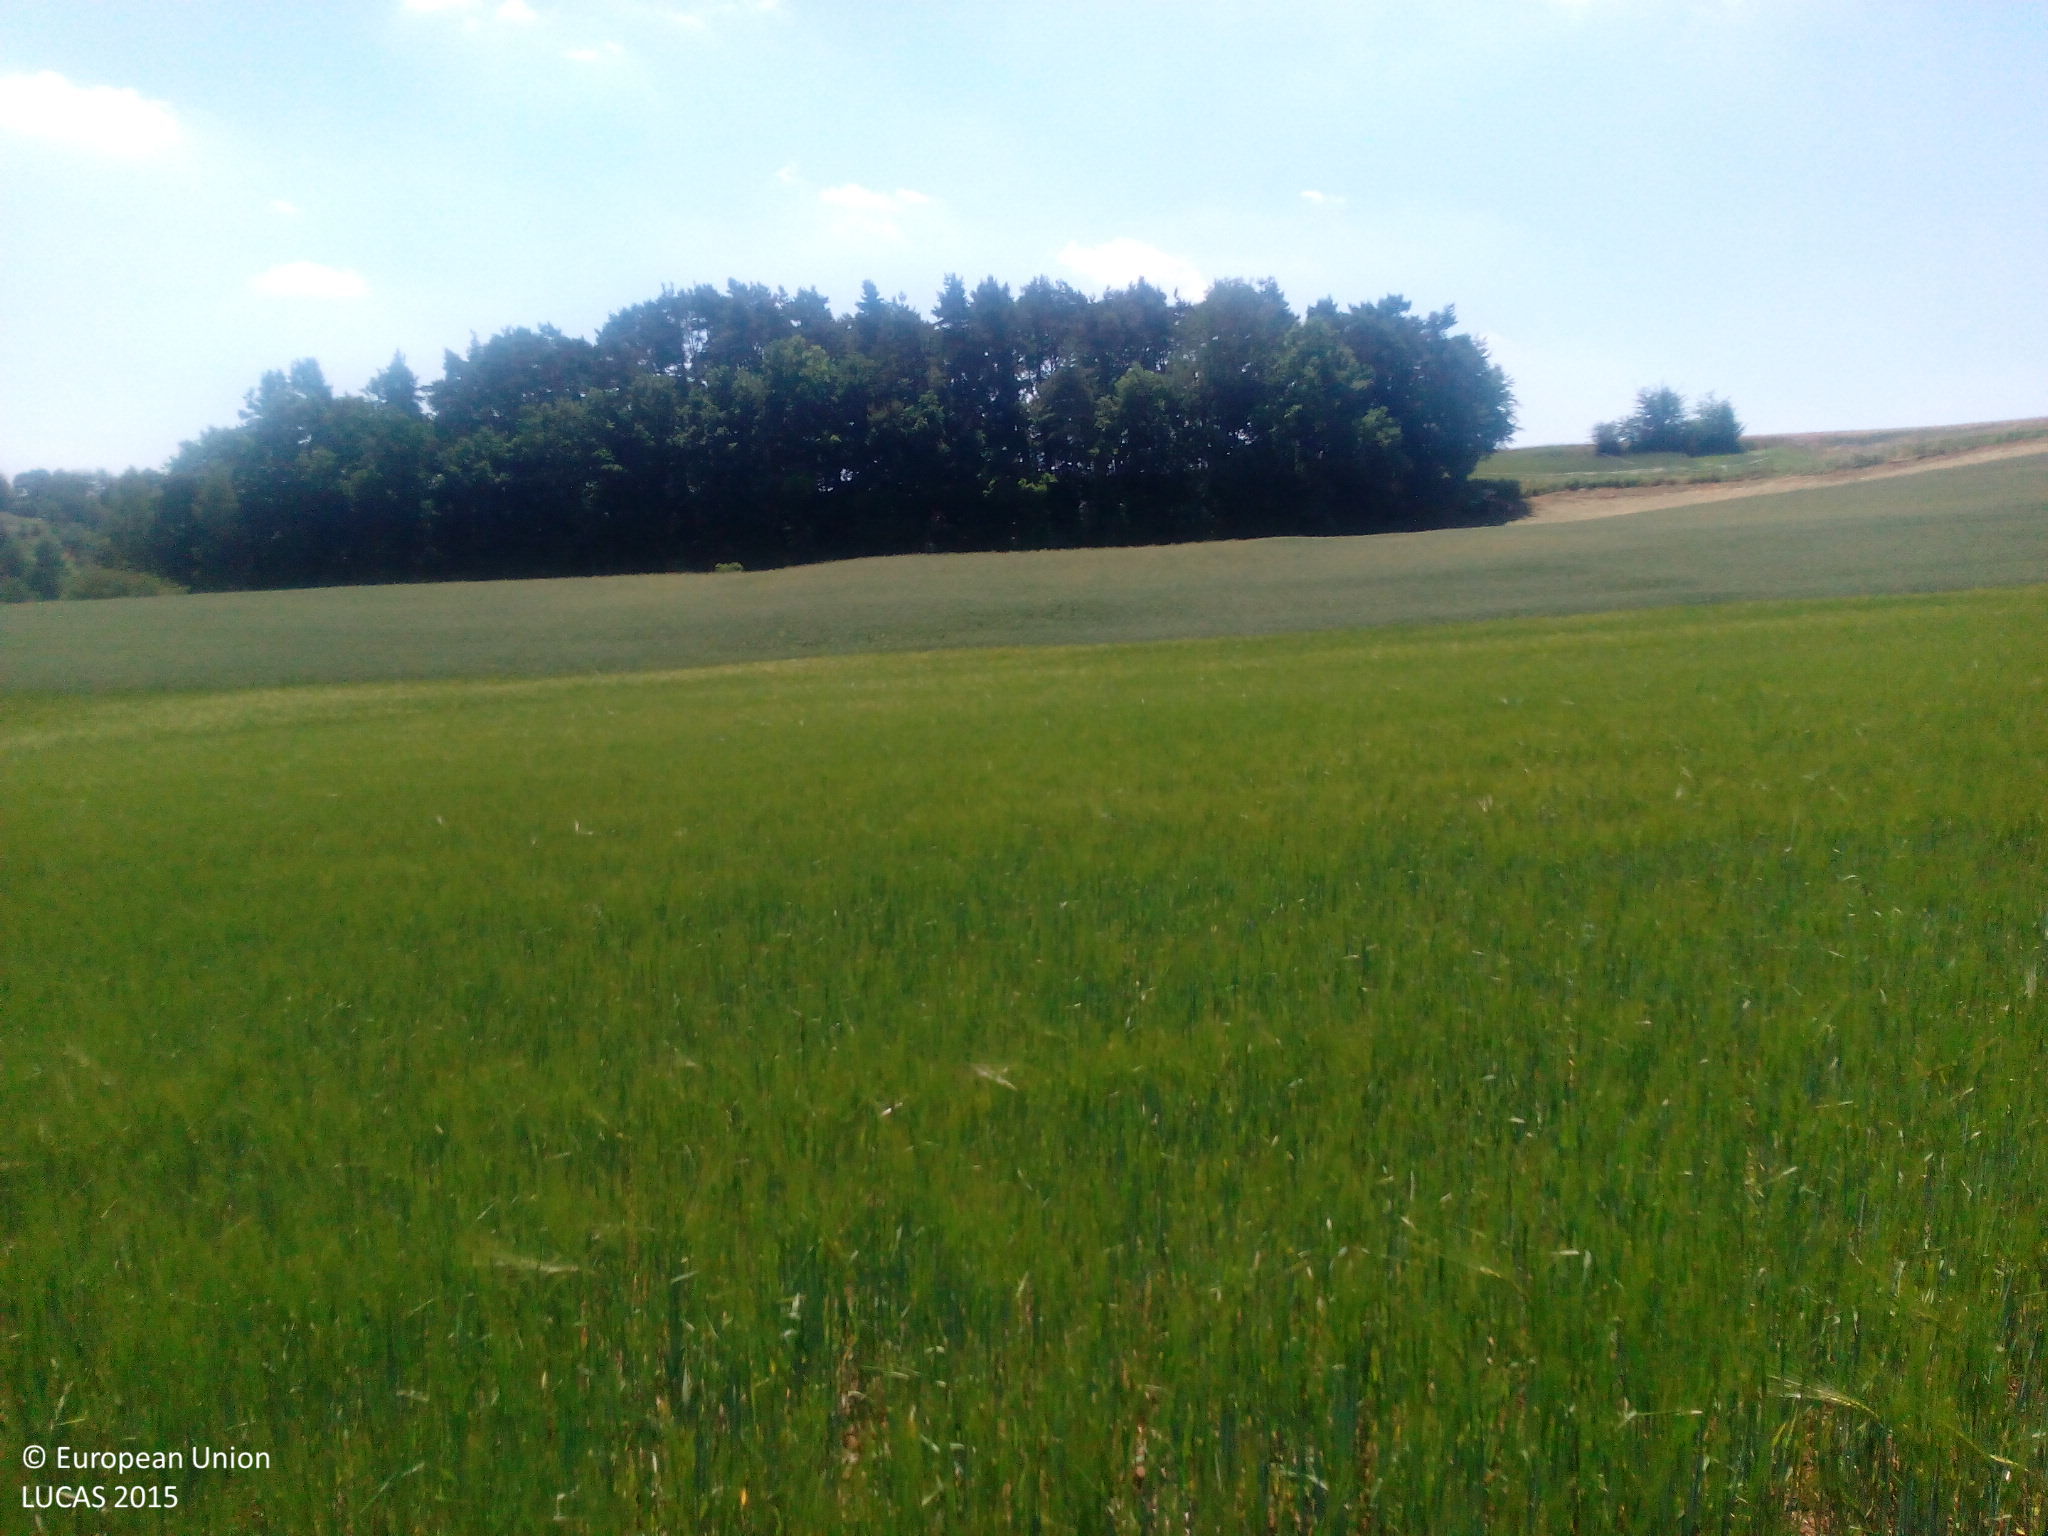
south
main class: Cropland
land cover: Barley
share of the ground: > 75 %
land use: Agriculture (excluding fallow land and kitchen gardens)
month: June
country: DE
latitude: 50.2184
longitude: 10.6305
